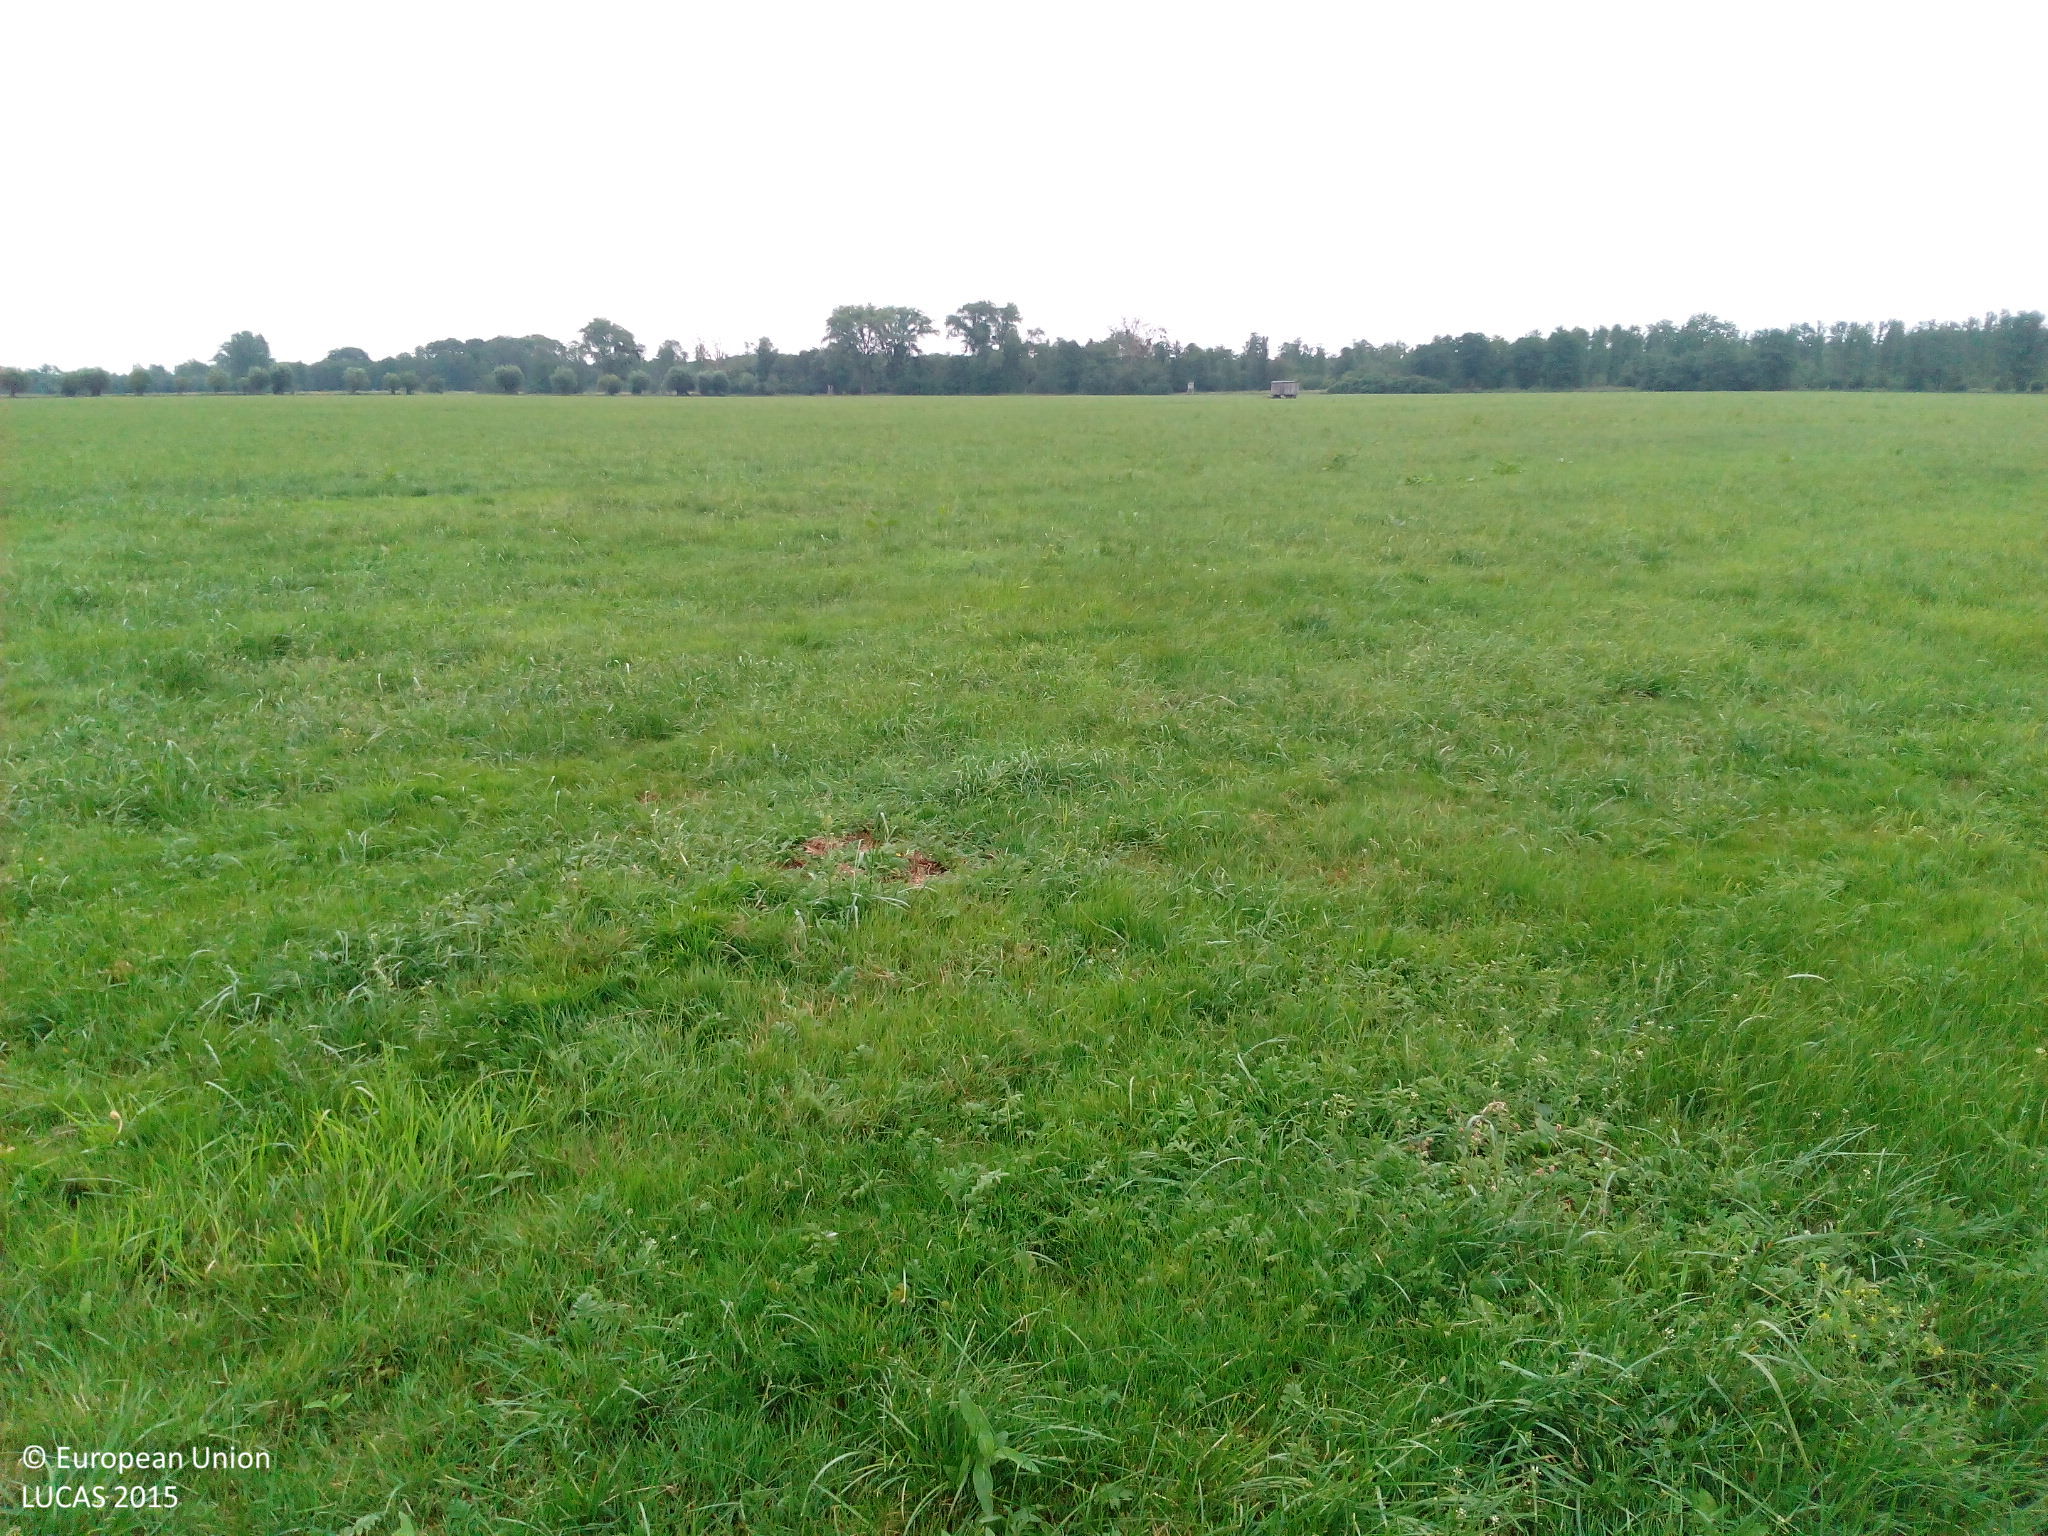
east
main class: Grassland
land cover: Grassland without tree/shrub cover
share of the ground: > 75 %
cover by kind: herbaceous plants 100 %
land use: Agriculture (excluding fallow land and kitchen gardens)
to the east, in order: Grassland without tree/shrub cover
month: August
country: DE
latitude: 53.8237
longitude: 12.5969
